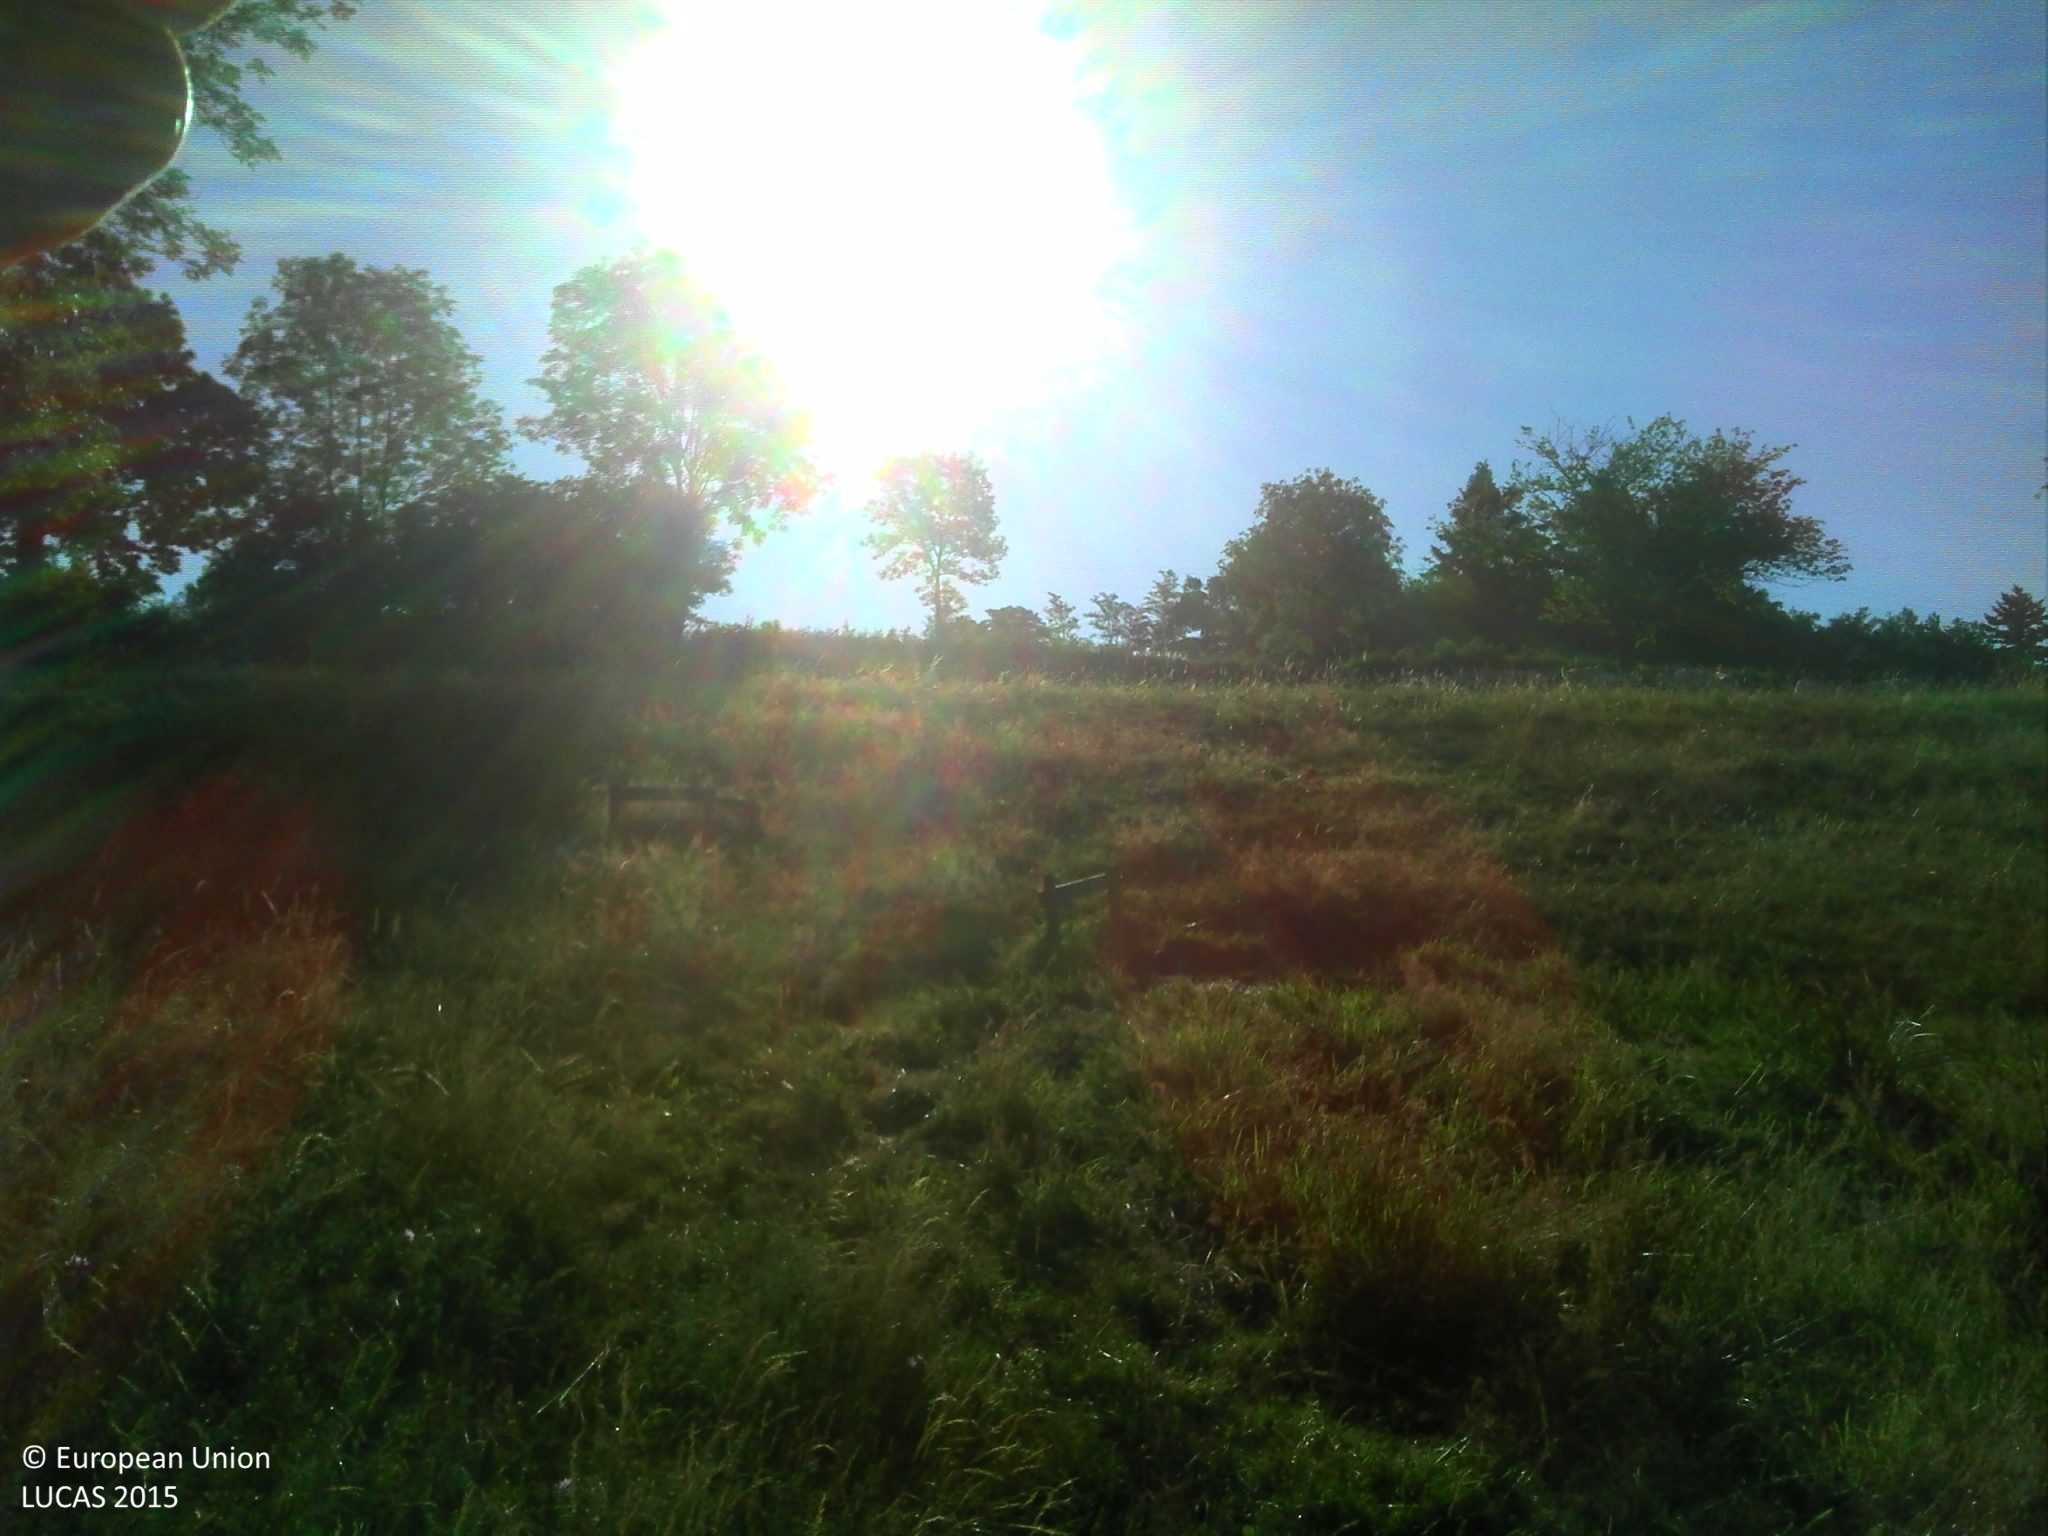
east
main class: Grassland
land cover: Grassland without tree/shrub cover
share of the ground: > 75 %
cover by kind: herbaceous plants 100 %
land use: Agriculture (excluding fallow land and kitchen gardens)
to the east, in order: Grassland without tree/shrub cover; Single bushes/trees; Managed hedges; Fences; Grassland without tree/shrub cover; Electric lines; Grassland without tree/shrub cover; Managed hedges; Fences; Broadleaved woodland; Grassland without tree/shrub cover
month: June
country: FR
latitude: 46.3889
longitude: 4.4749
